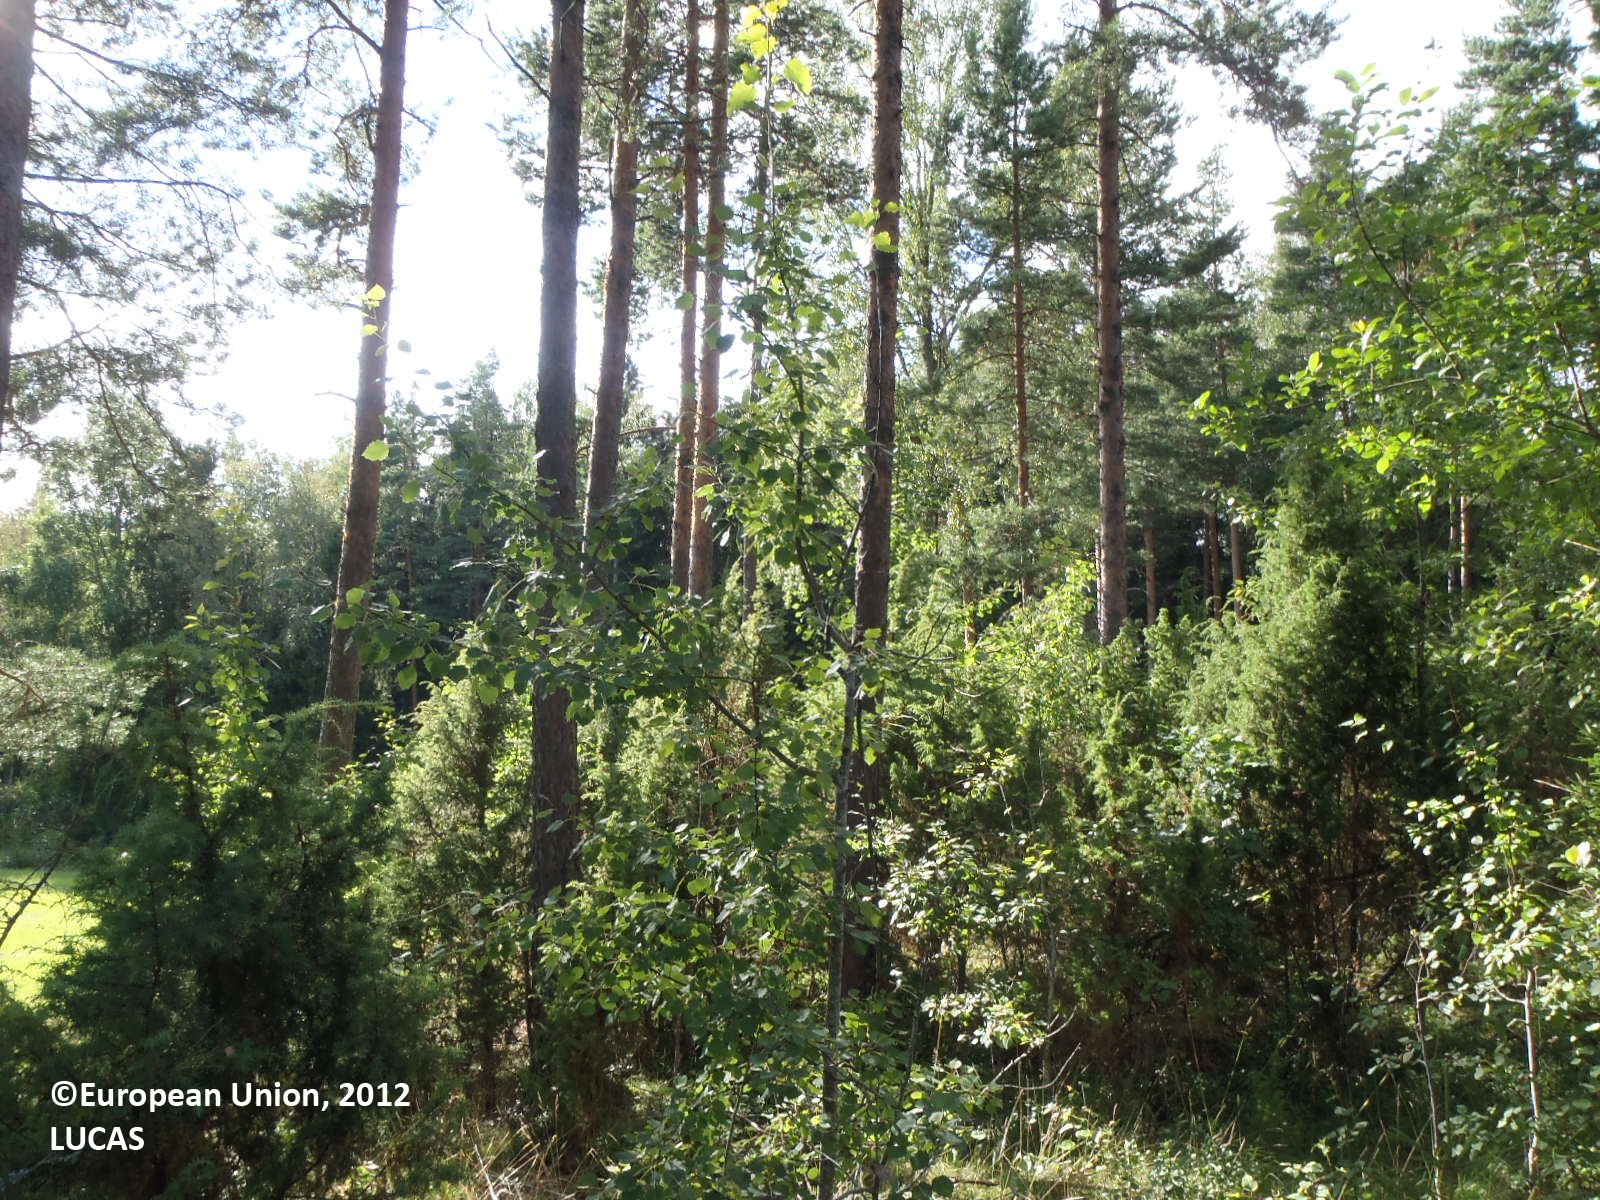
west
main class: Woodland
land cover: Pine dominated coniferous woodland
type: boreal forest
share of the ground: > 75 %
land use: Forestry
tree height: > 5 m
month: August
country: FI
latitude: 60.3308
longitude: 22.3301
